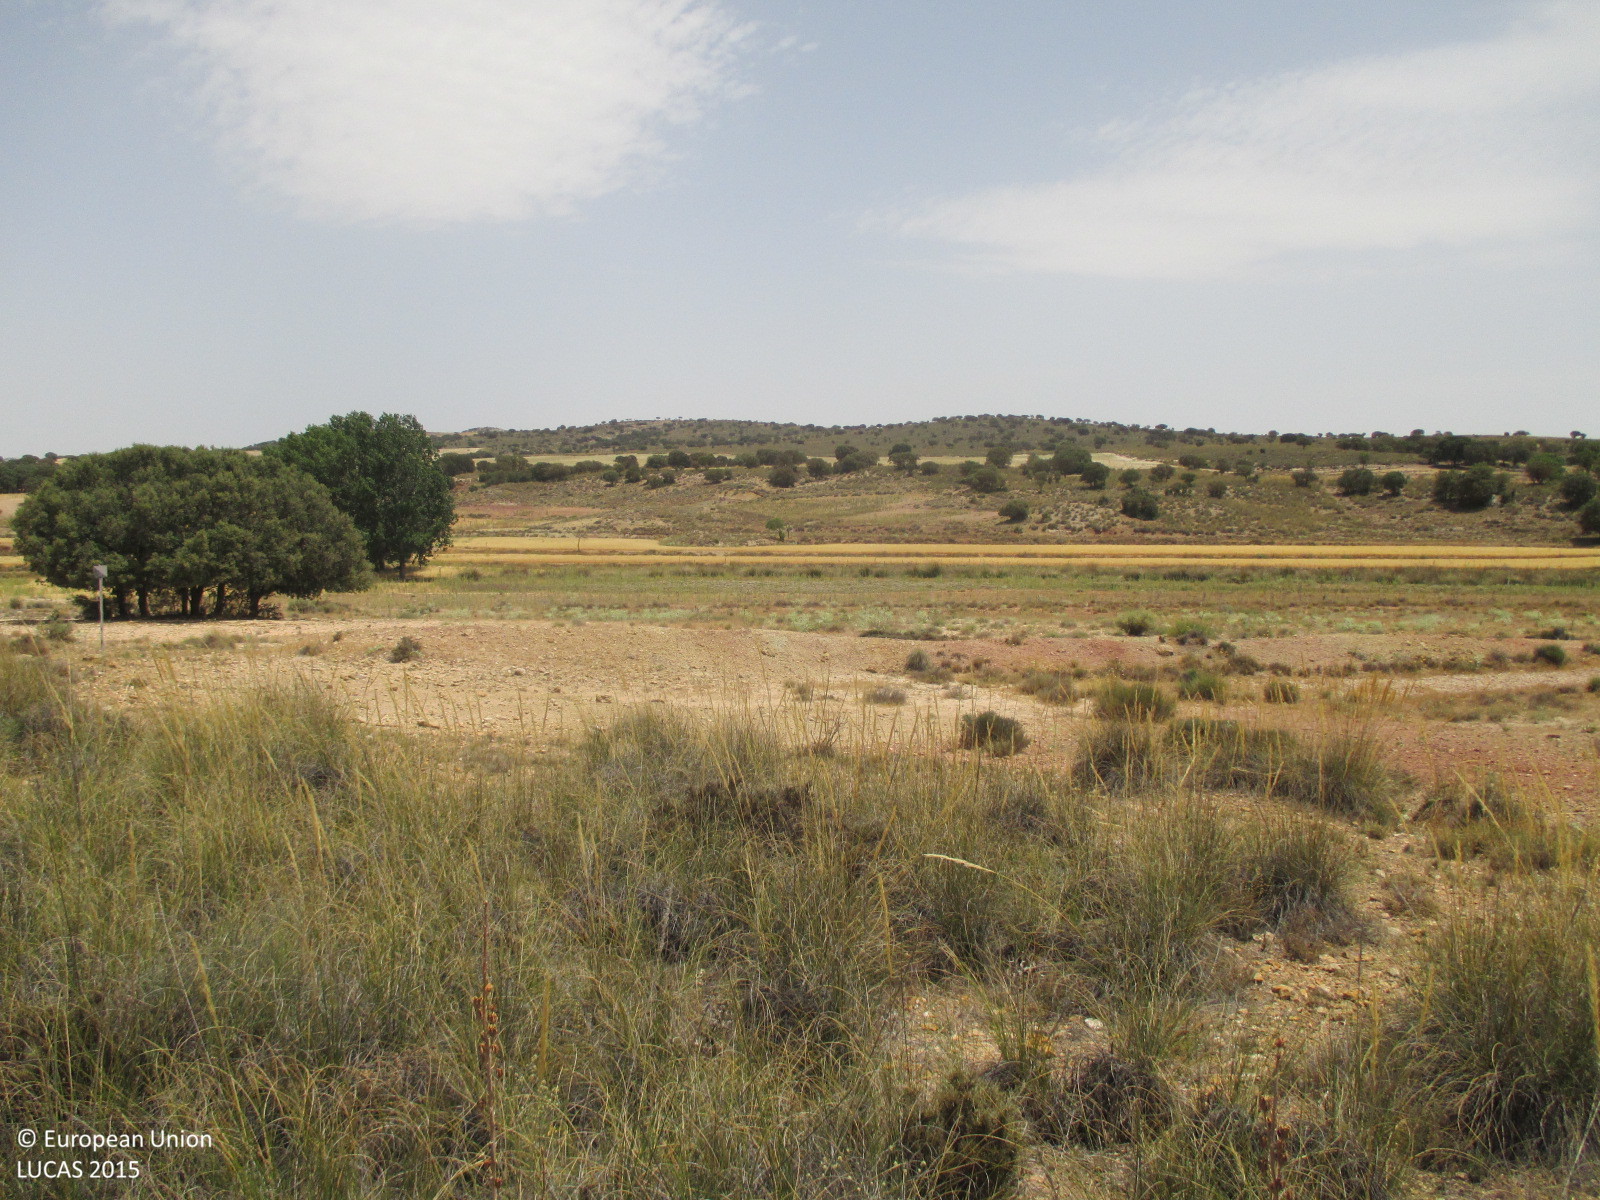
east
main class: Grassland
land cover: Grassland without tree/shrub cover
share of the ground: > 75 %
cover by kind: herbaceous plants 95 %, consolidated bare surface 5 %
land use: Semi-natural and natural areas not in use
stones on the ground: < 10 %
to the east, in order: Grassland without tree/shrub cover; Single bushes/trees; Grassland without tree/shrub cover; Grass margins; Other bare soil; Dry stone walls; Broadleaved woodland; Tracks; Grass margins; Oats; Grass margins; Ditches and canals
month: July
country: ES
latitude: 37.8619
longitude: -2.2990
